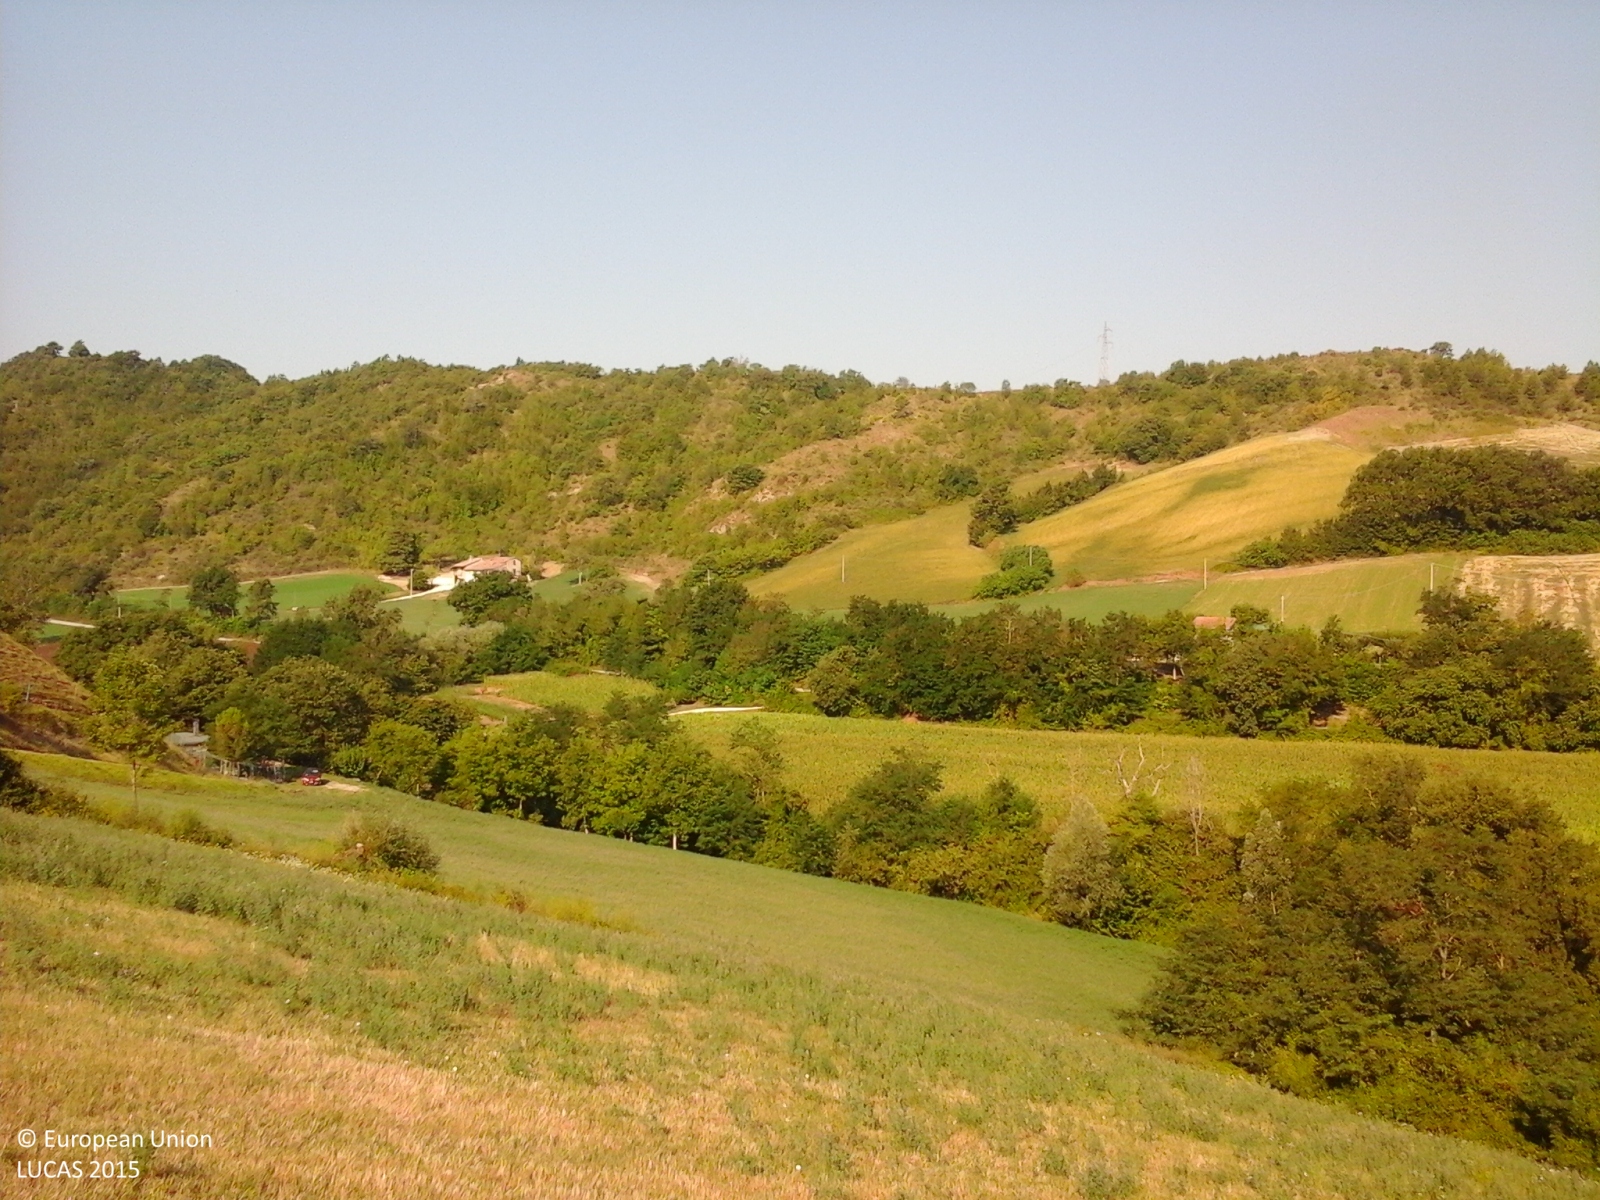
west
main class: Cropland
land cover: Lucerne
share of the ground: > 75 %
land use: Agriculture (excluding fallow land and kitchen gardens)
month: August
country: IT
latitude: 43.6548
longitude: 12.4117
